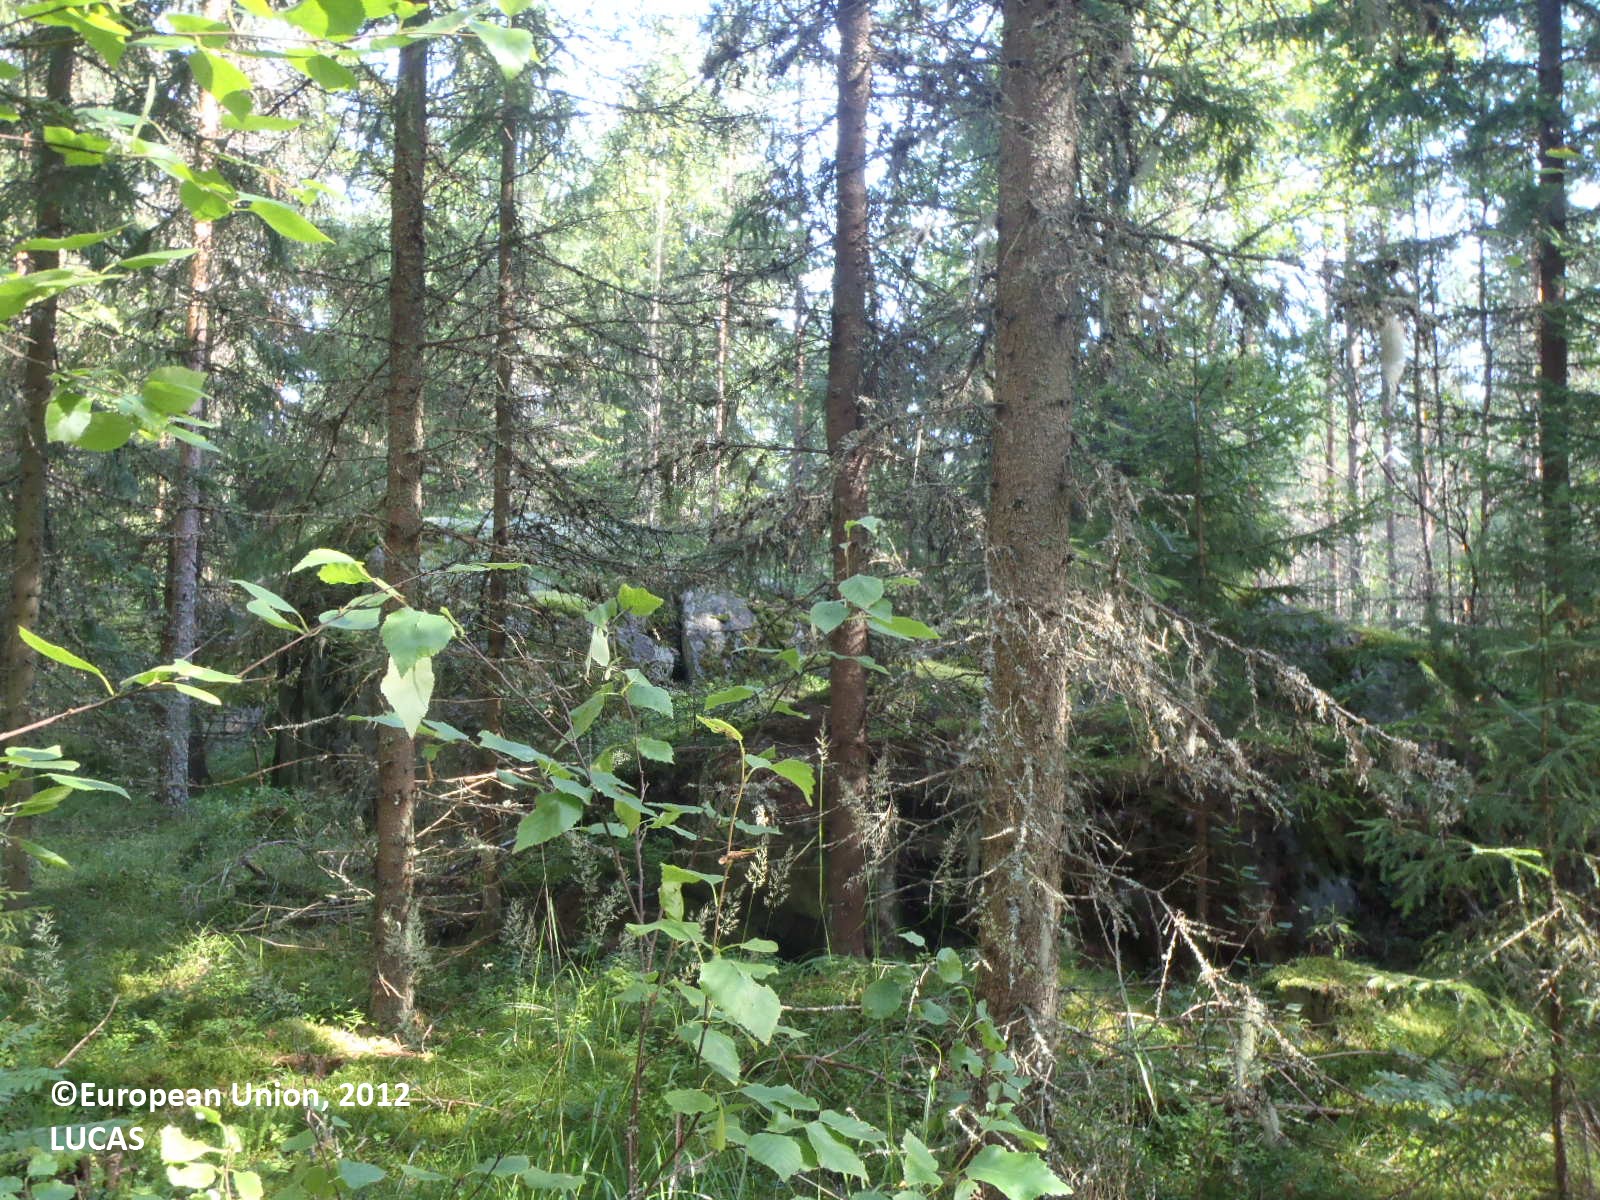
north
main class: Woodland
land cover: Pine dominated mixed woodland
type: boreal forest
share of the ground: > 75 %
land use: Forestry
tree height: > 5 m
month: August
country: FI
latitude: 60.9376
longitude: 21.8509
